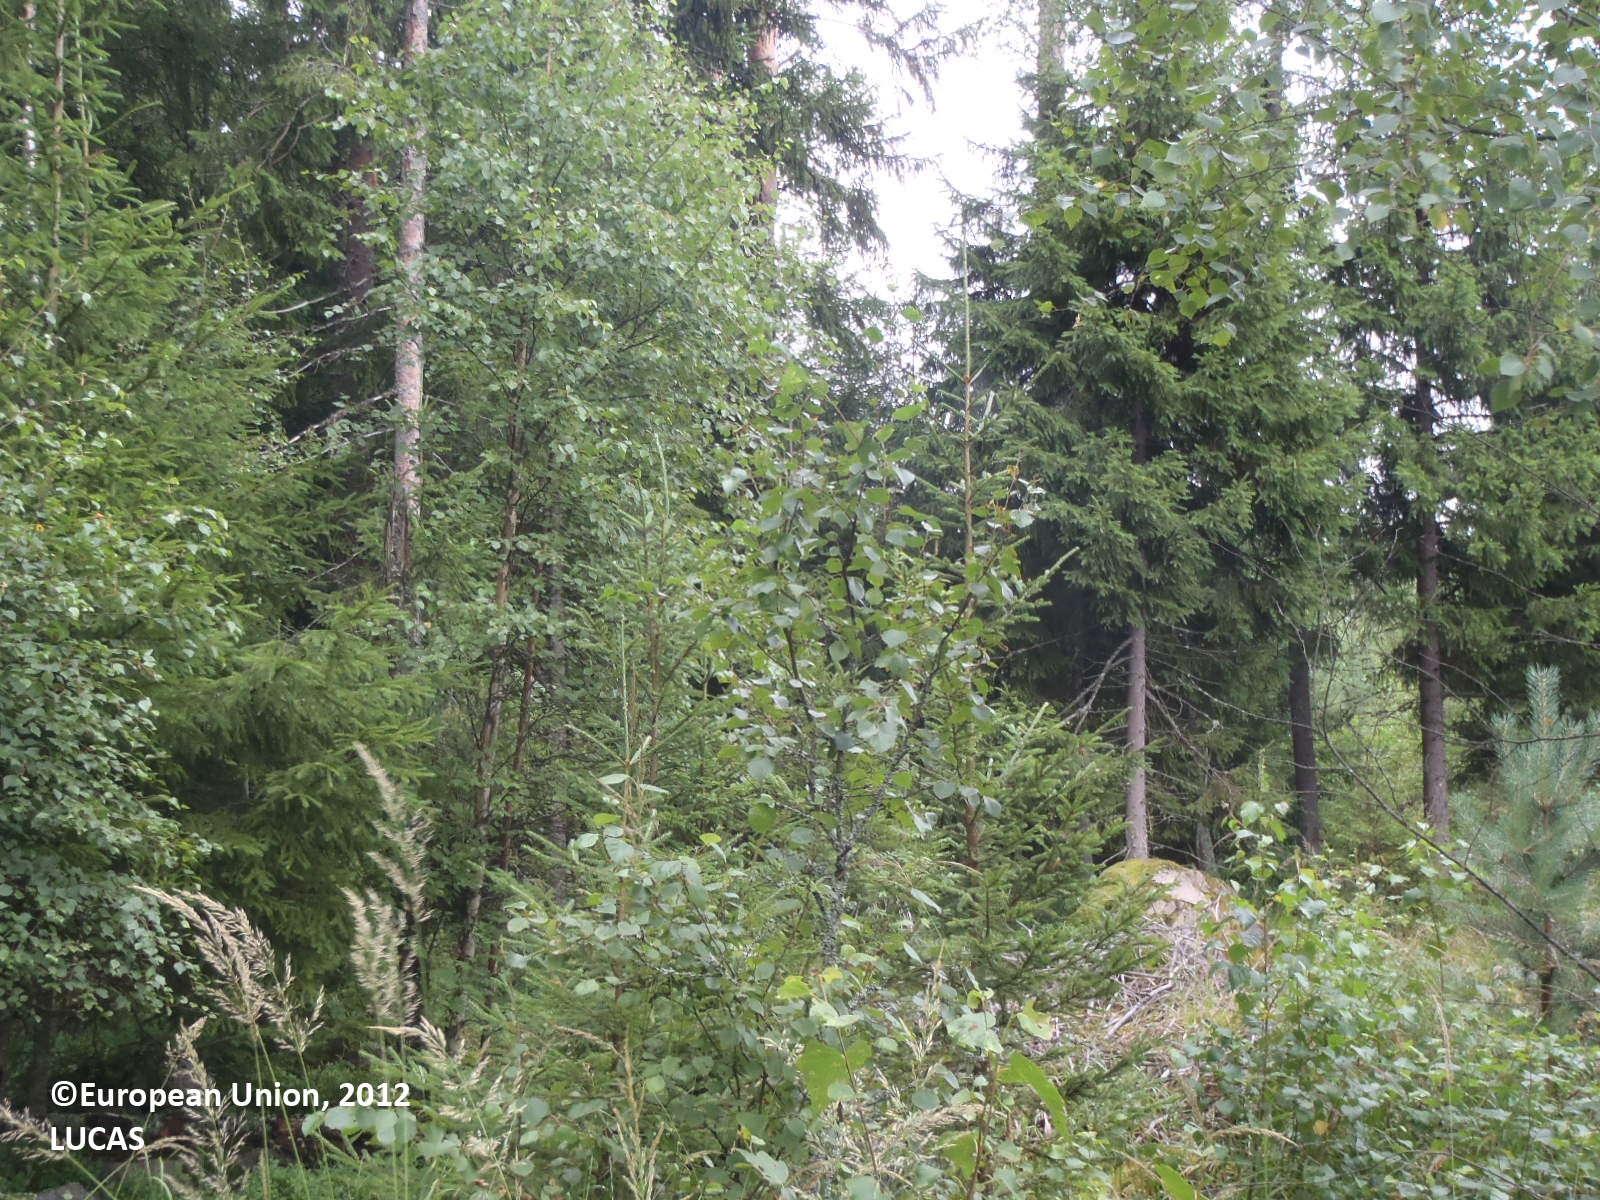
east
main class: Woodland
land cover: Other mixed woodland
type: boreal forest
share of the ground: > 75 %
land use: Forestry
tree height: > 5 m
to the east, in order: Other mixed woodland; Pine dominated coniferous woodland; Pine dominated mixed woodland; Ditches and canals; Pine dominated mixed woodland
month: July
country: FI
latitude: 60.7782
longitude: 21.7926
